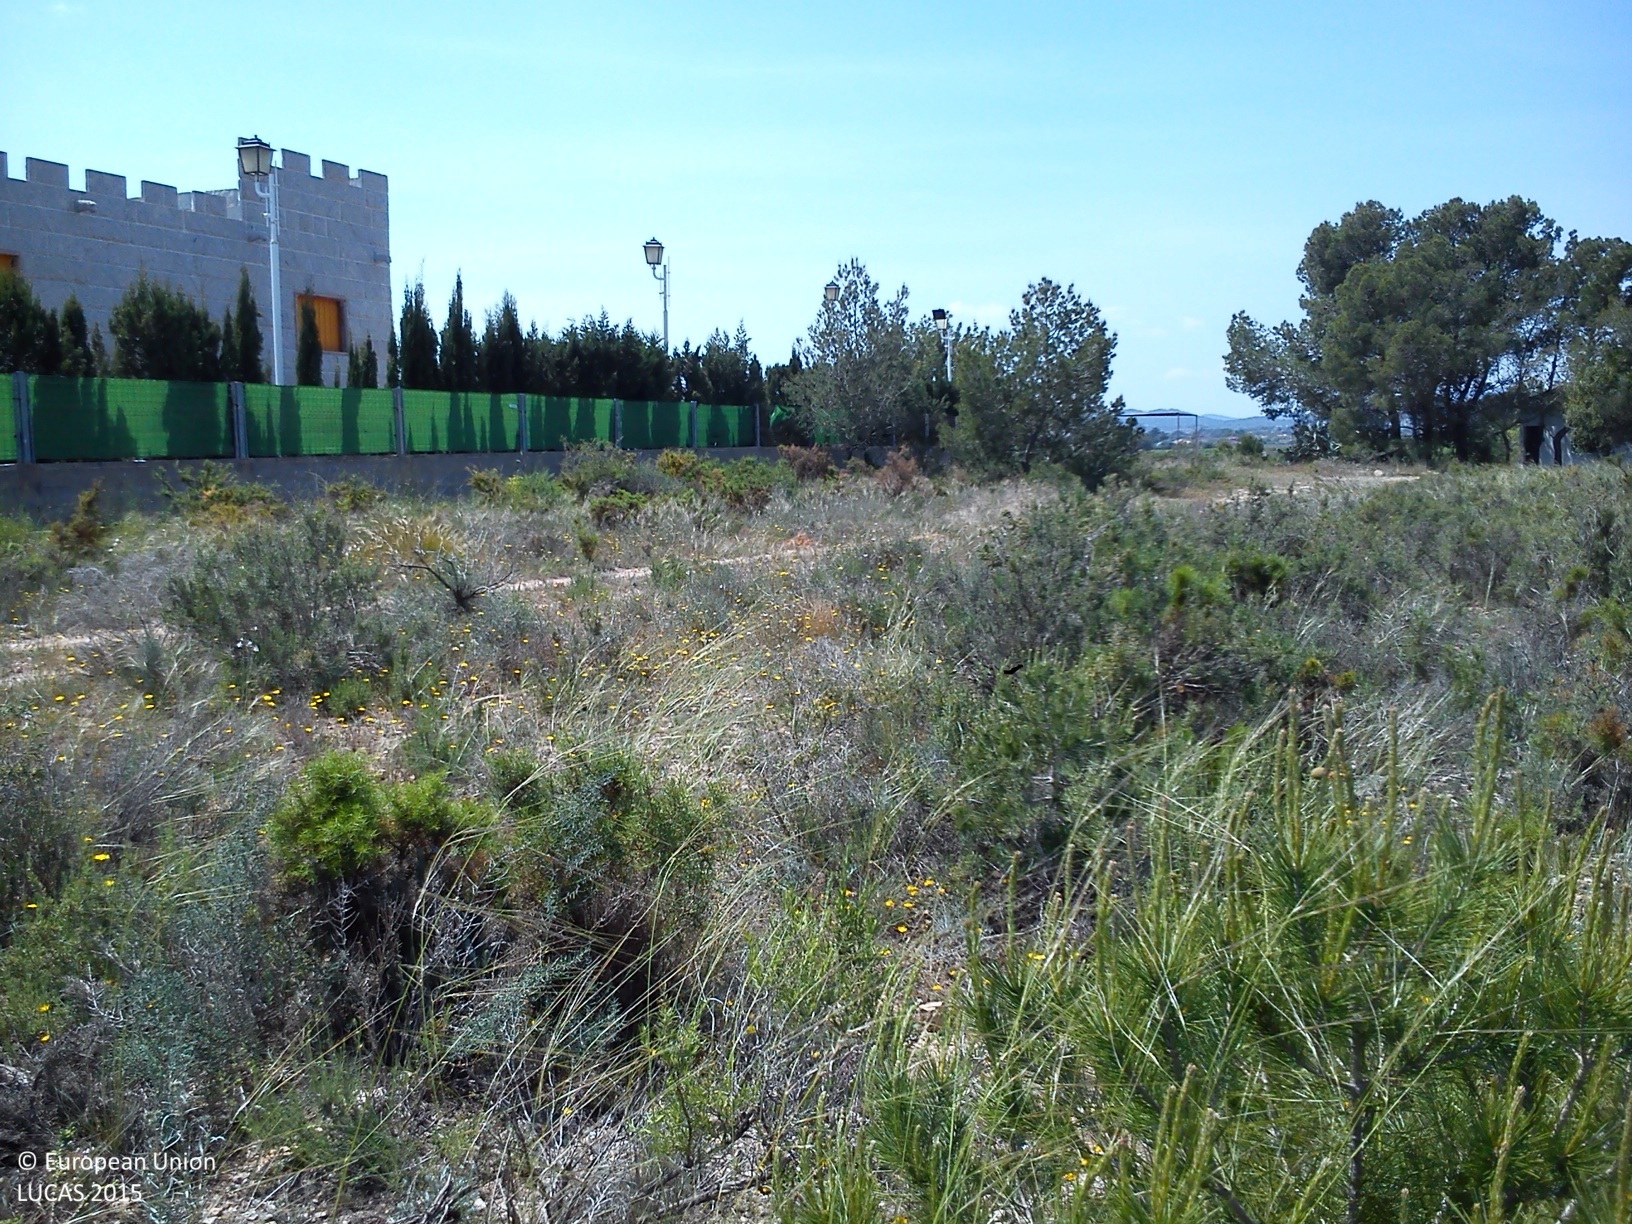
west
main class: Shrubland
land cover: Shrubland with sparse tree cover
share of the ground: > 75 %
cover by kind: shrubs 80 %, herbaceous plants 15 %, coniferous forest trees 5 %
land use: Semi-natural and natural areas not in use
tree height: < 5 m
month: April
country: ES
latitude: 39.6505
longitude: -0.6407
